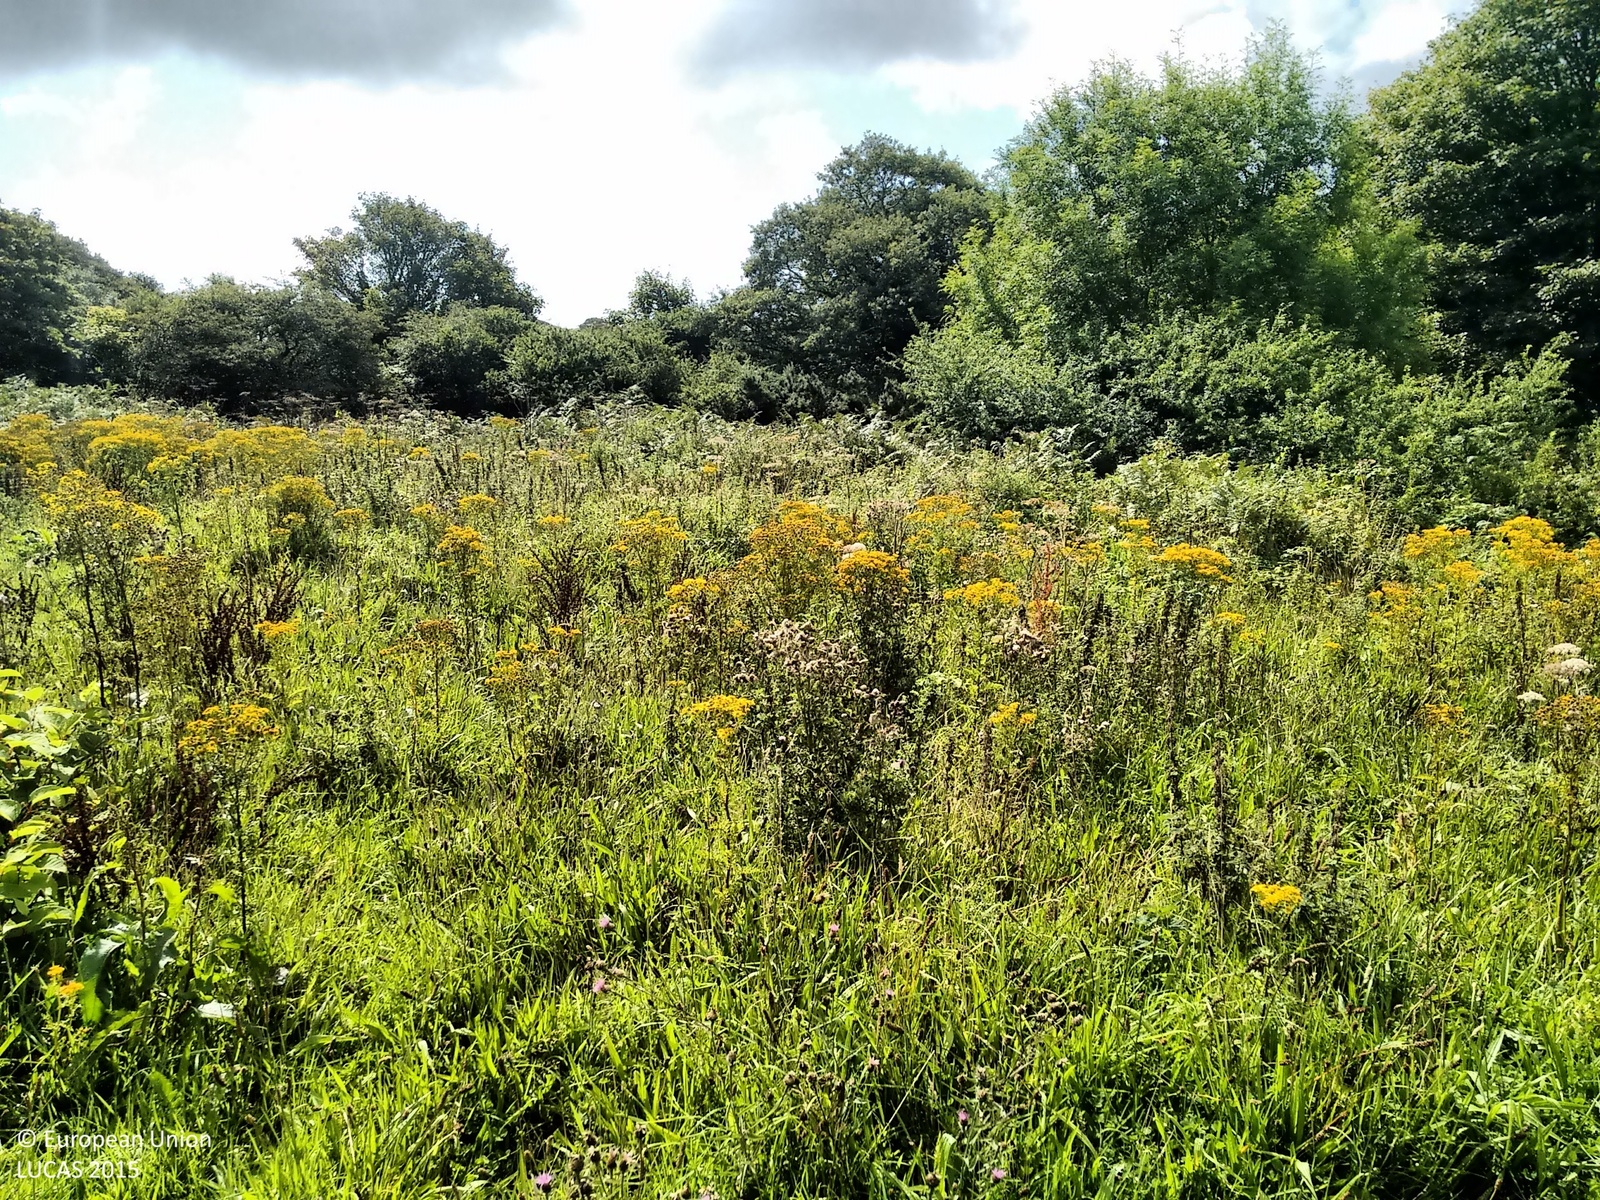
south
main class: Grassland
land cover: Grassland without tree/shrub cover
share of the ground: > 75 %
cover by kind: herbaceous plants 100 %
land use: Agriculture (excluding fallow land and kitchen gardens)
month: August
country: GB
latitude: 50.1882
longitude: -5.2910
